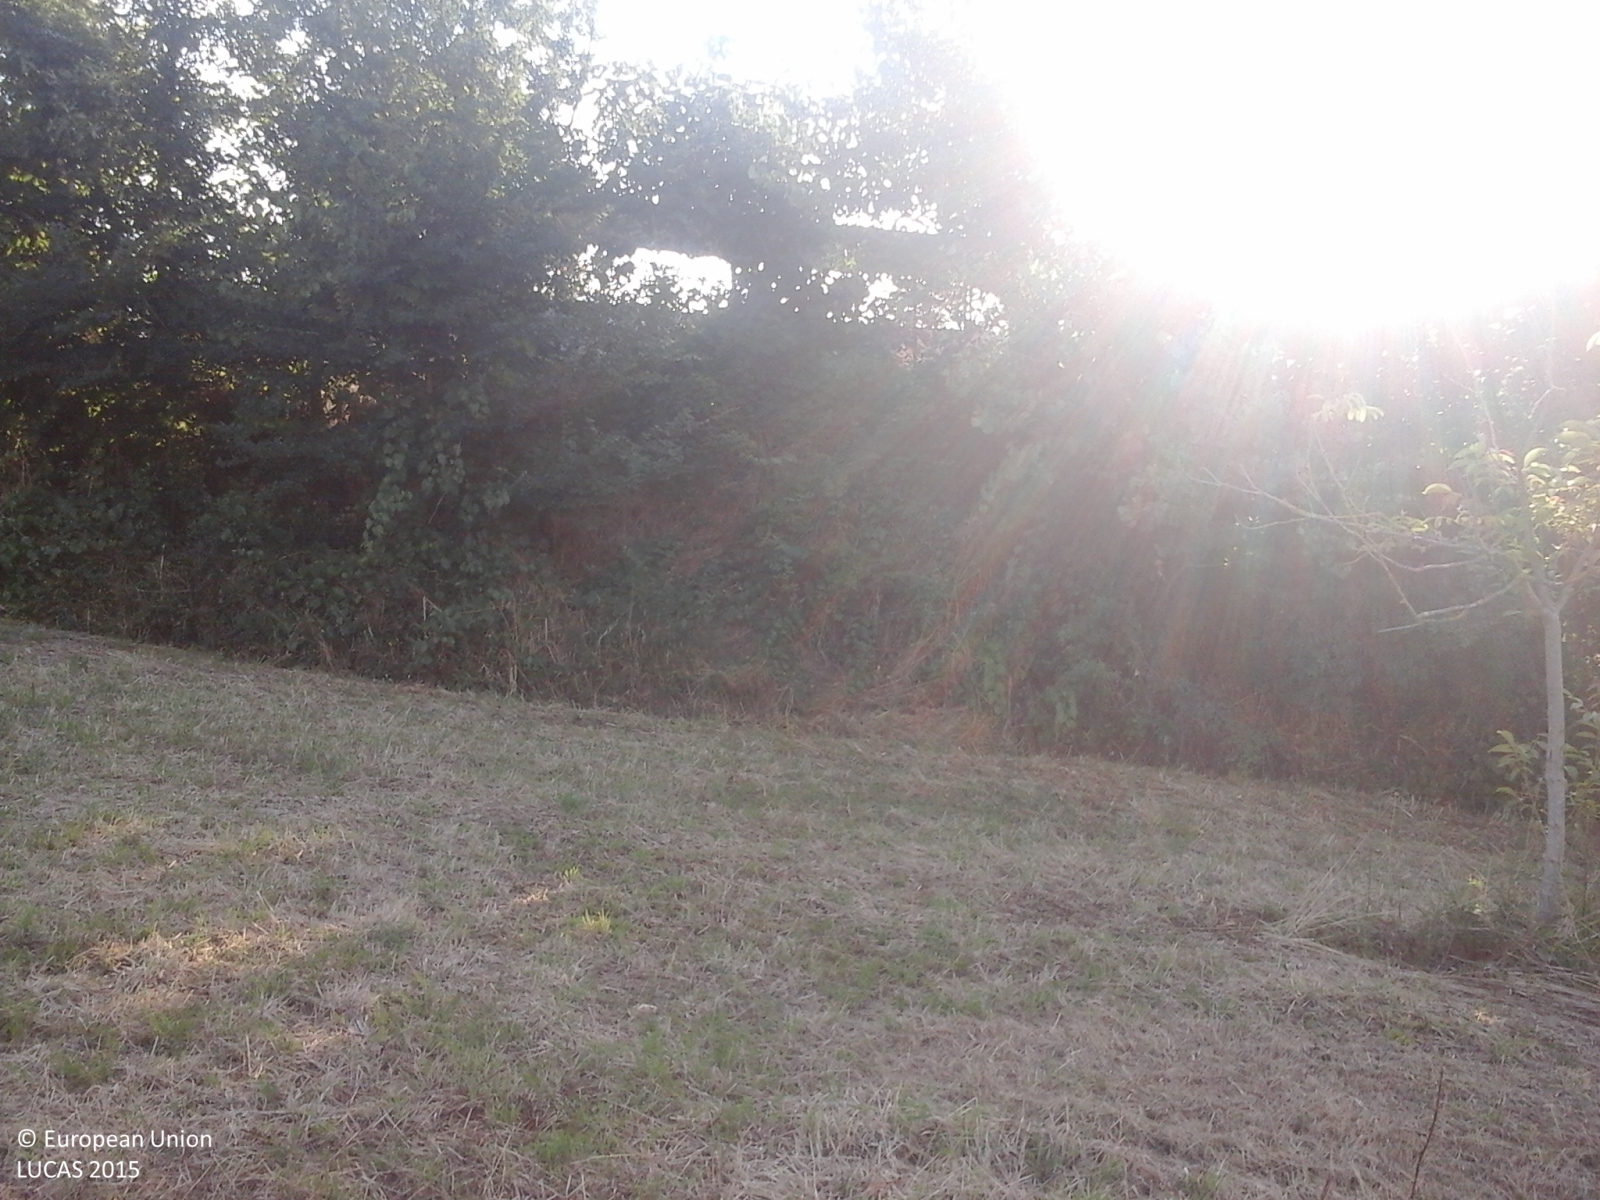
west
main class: Cropland
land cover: Nuts trees
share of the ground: 25 - 50 %
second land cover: Grassland without tree/shrub cover
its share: > 75 %
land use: Agriculture (excluding fallow land and kitchen gardens)
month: June
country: IT
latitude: 43.7878
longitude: 10.8552
